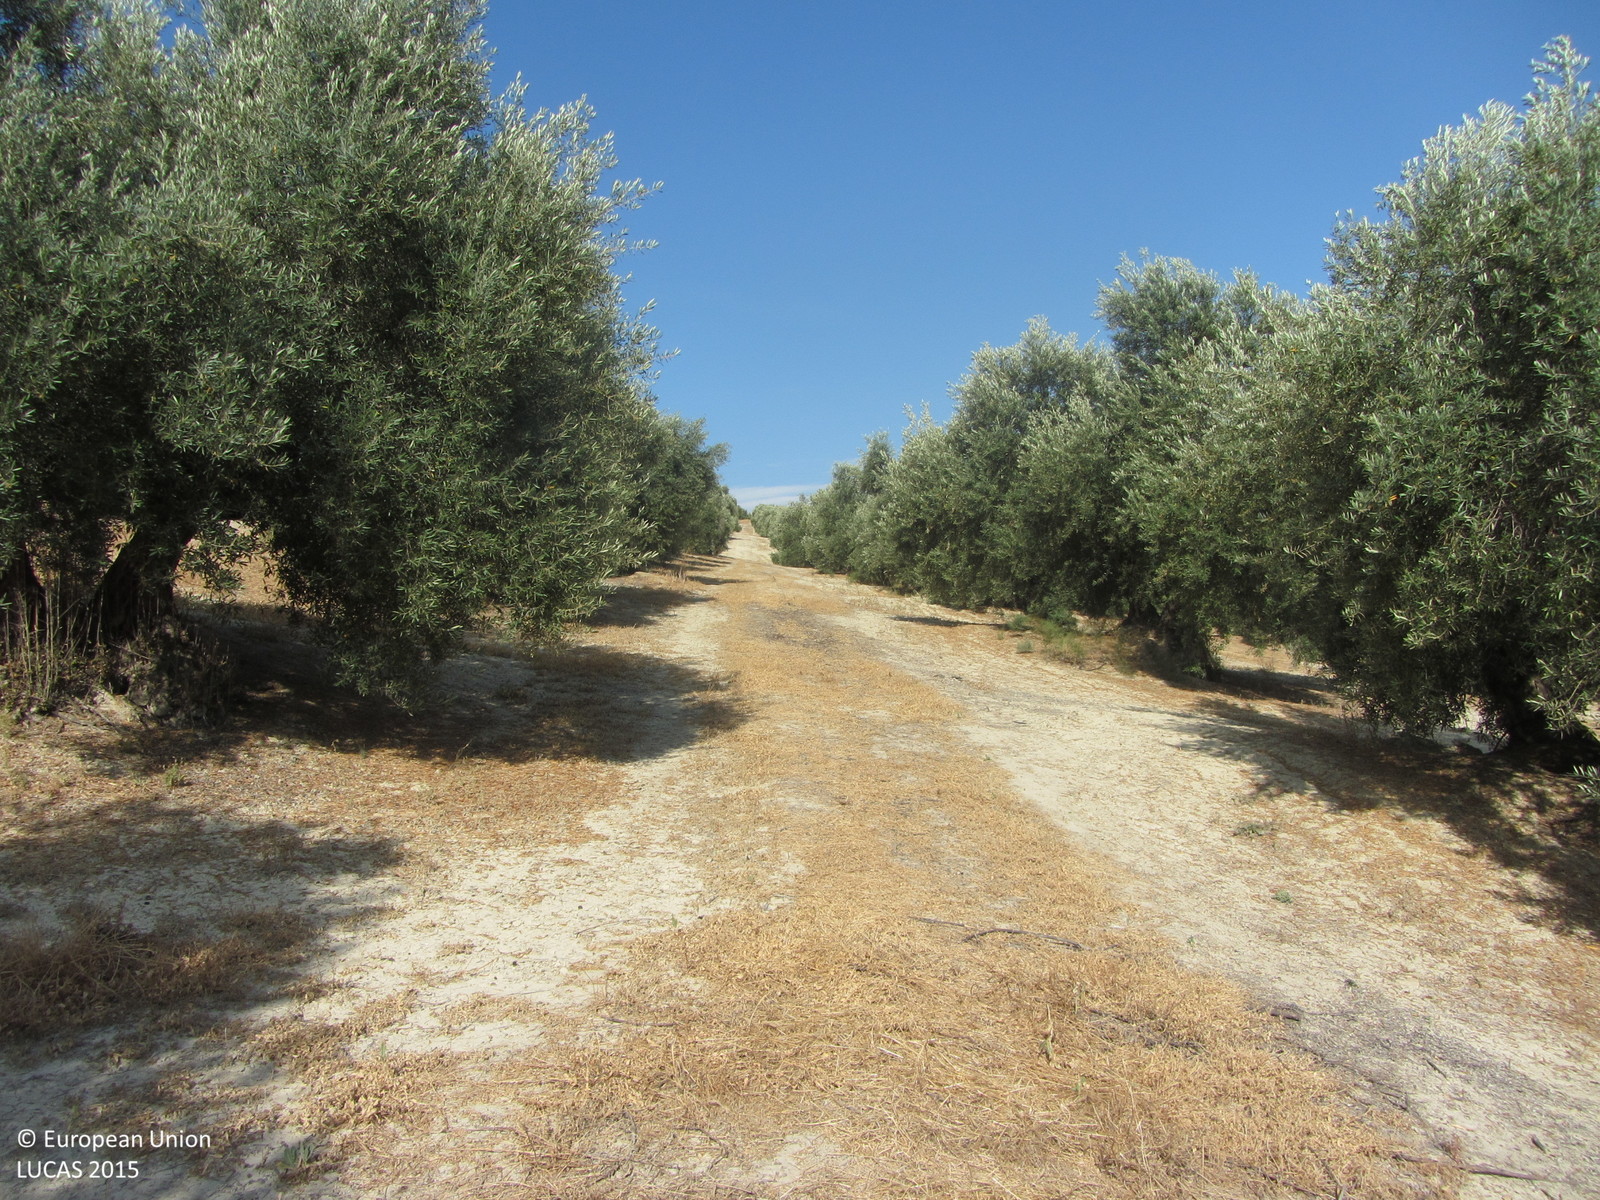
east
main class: Cropland
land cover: Olive groves
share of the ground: 50 - 75 %
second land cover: Other bare soil
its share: > 75 %
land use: Agriculture (excluding fallow land and kitchen gardens)
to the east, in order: Olive groves; Other bare soil
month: June
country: ES
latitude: 37.9703
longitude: -3.2599
